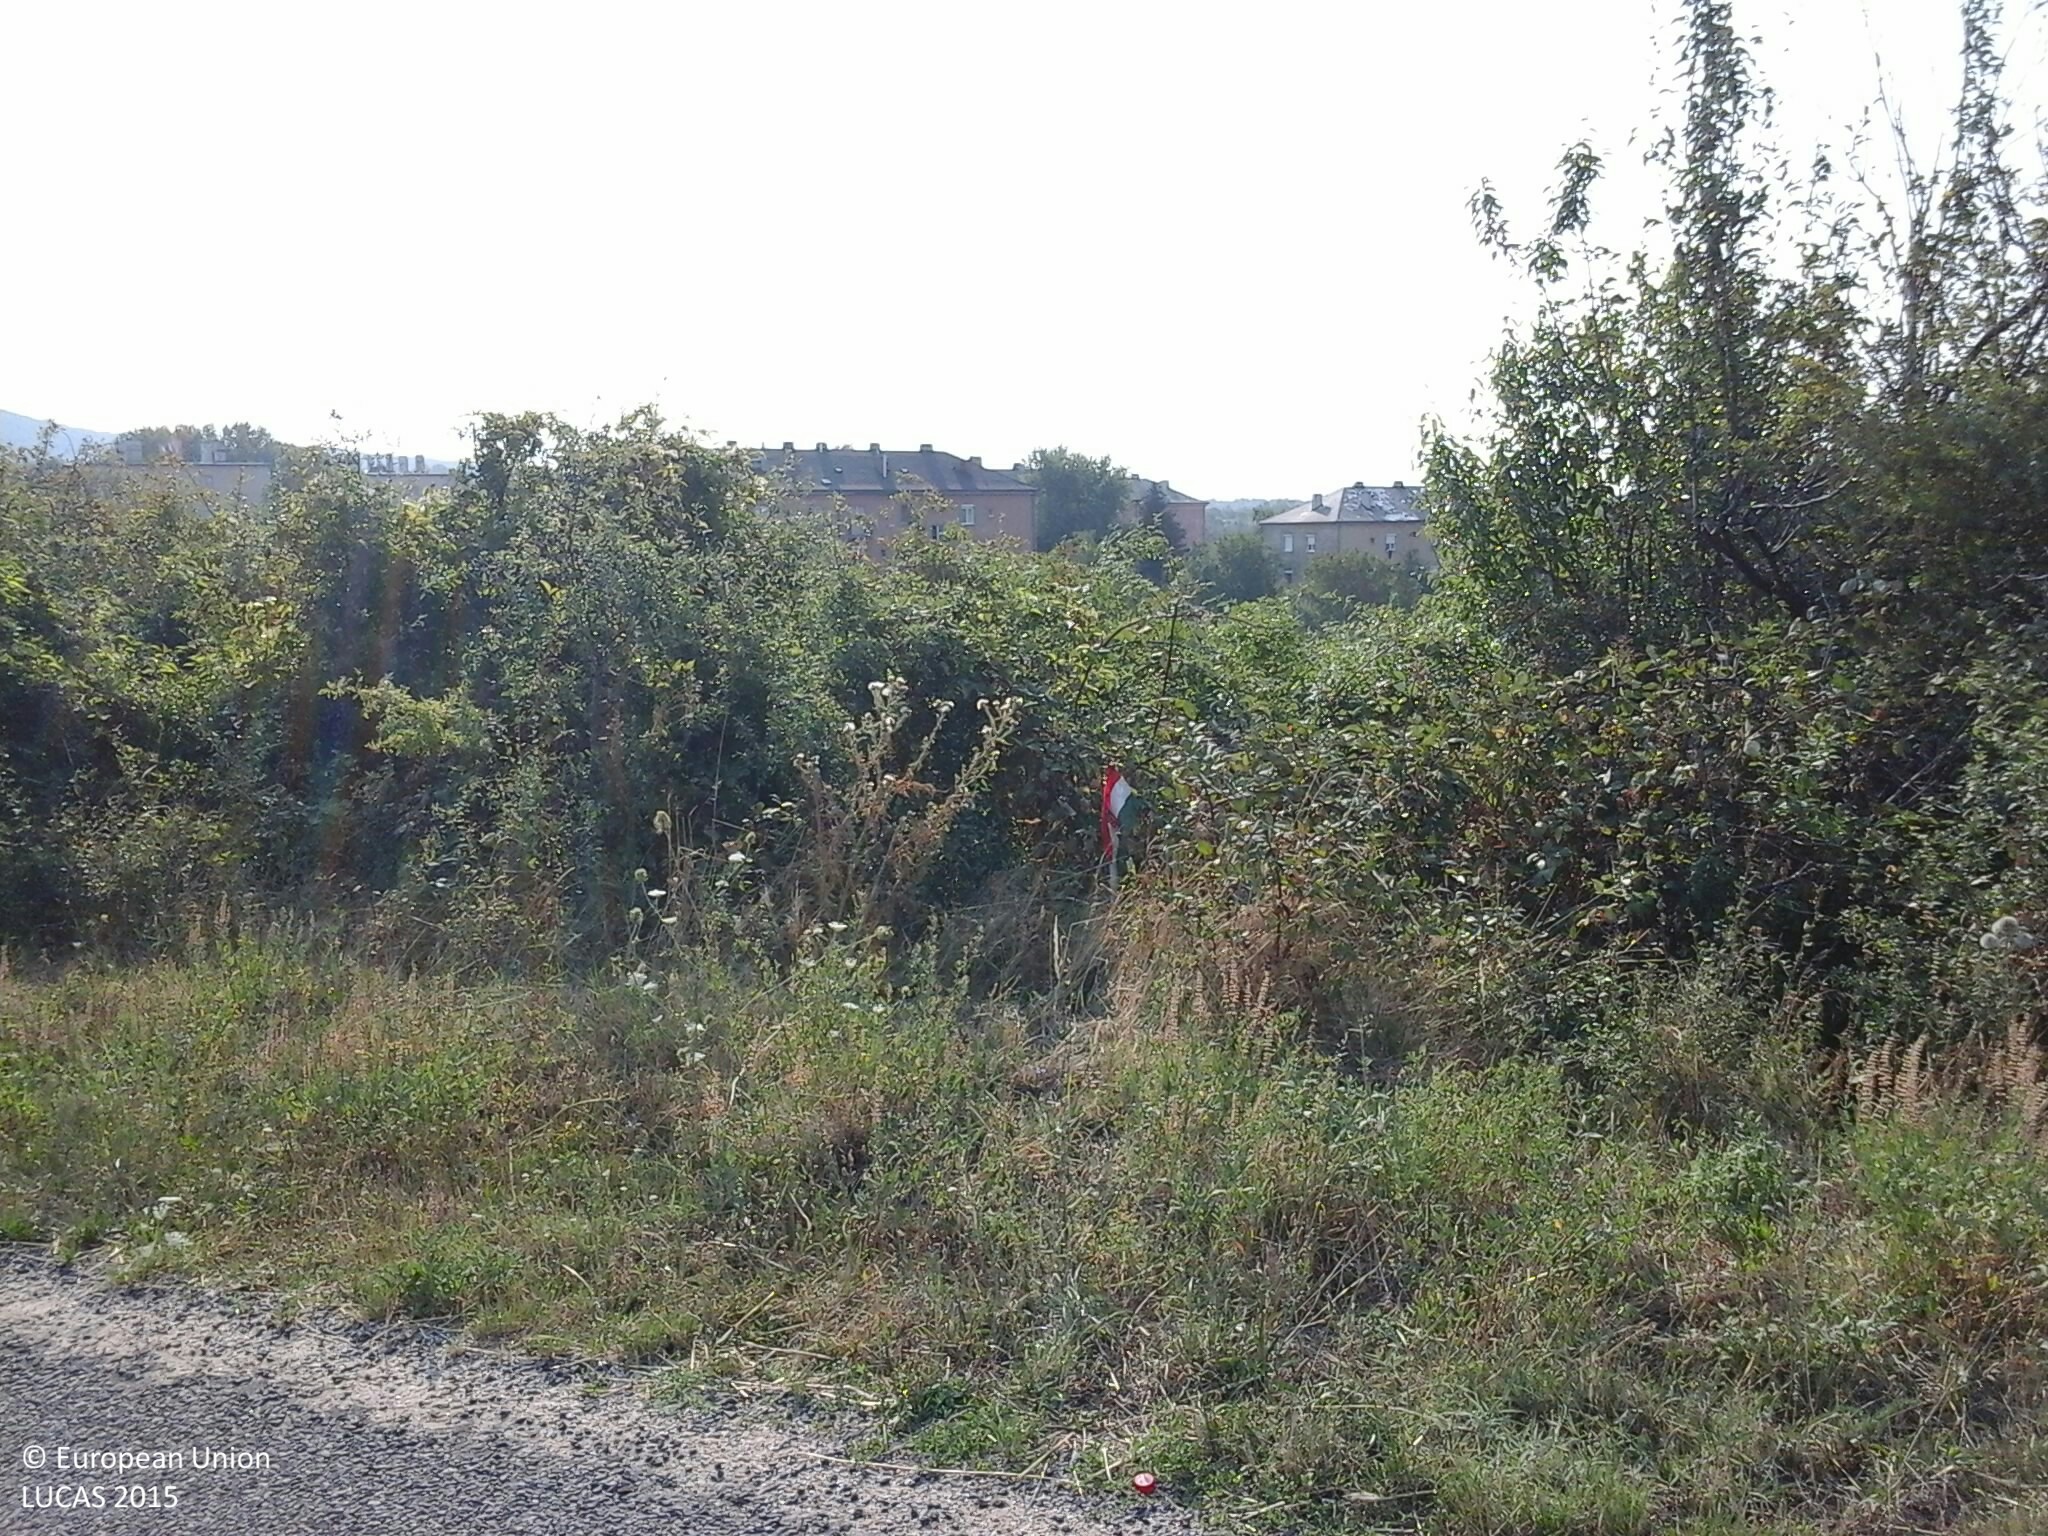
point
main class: Shrubland
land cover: Shrubland without tree cover
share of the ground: > 75 %
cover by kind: shrubs 100 %
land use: Semi-natural and natural areas not in use
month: August
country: HU
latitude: 46.0788
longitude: 18.1141
